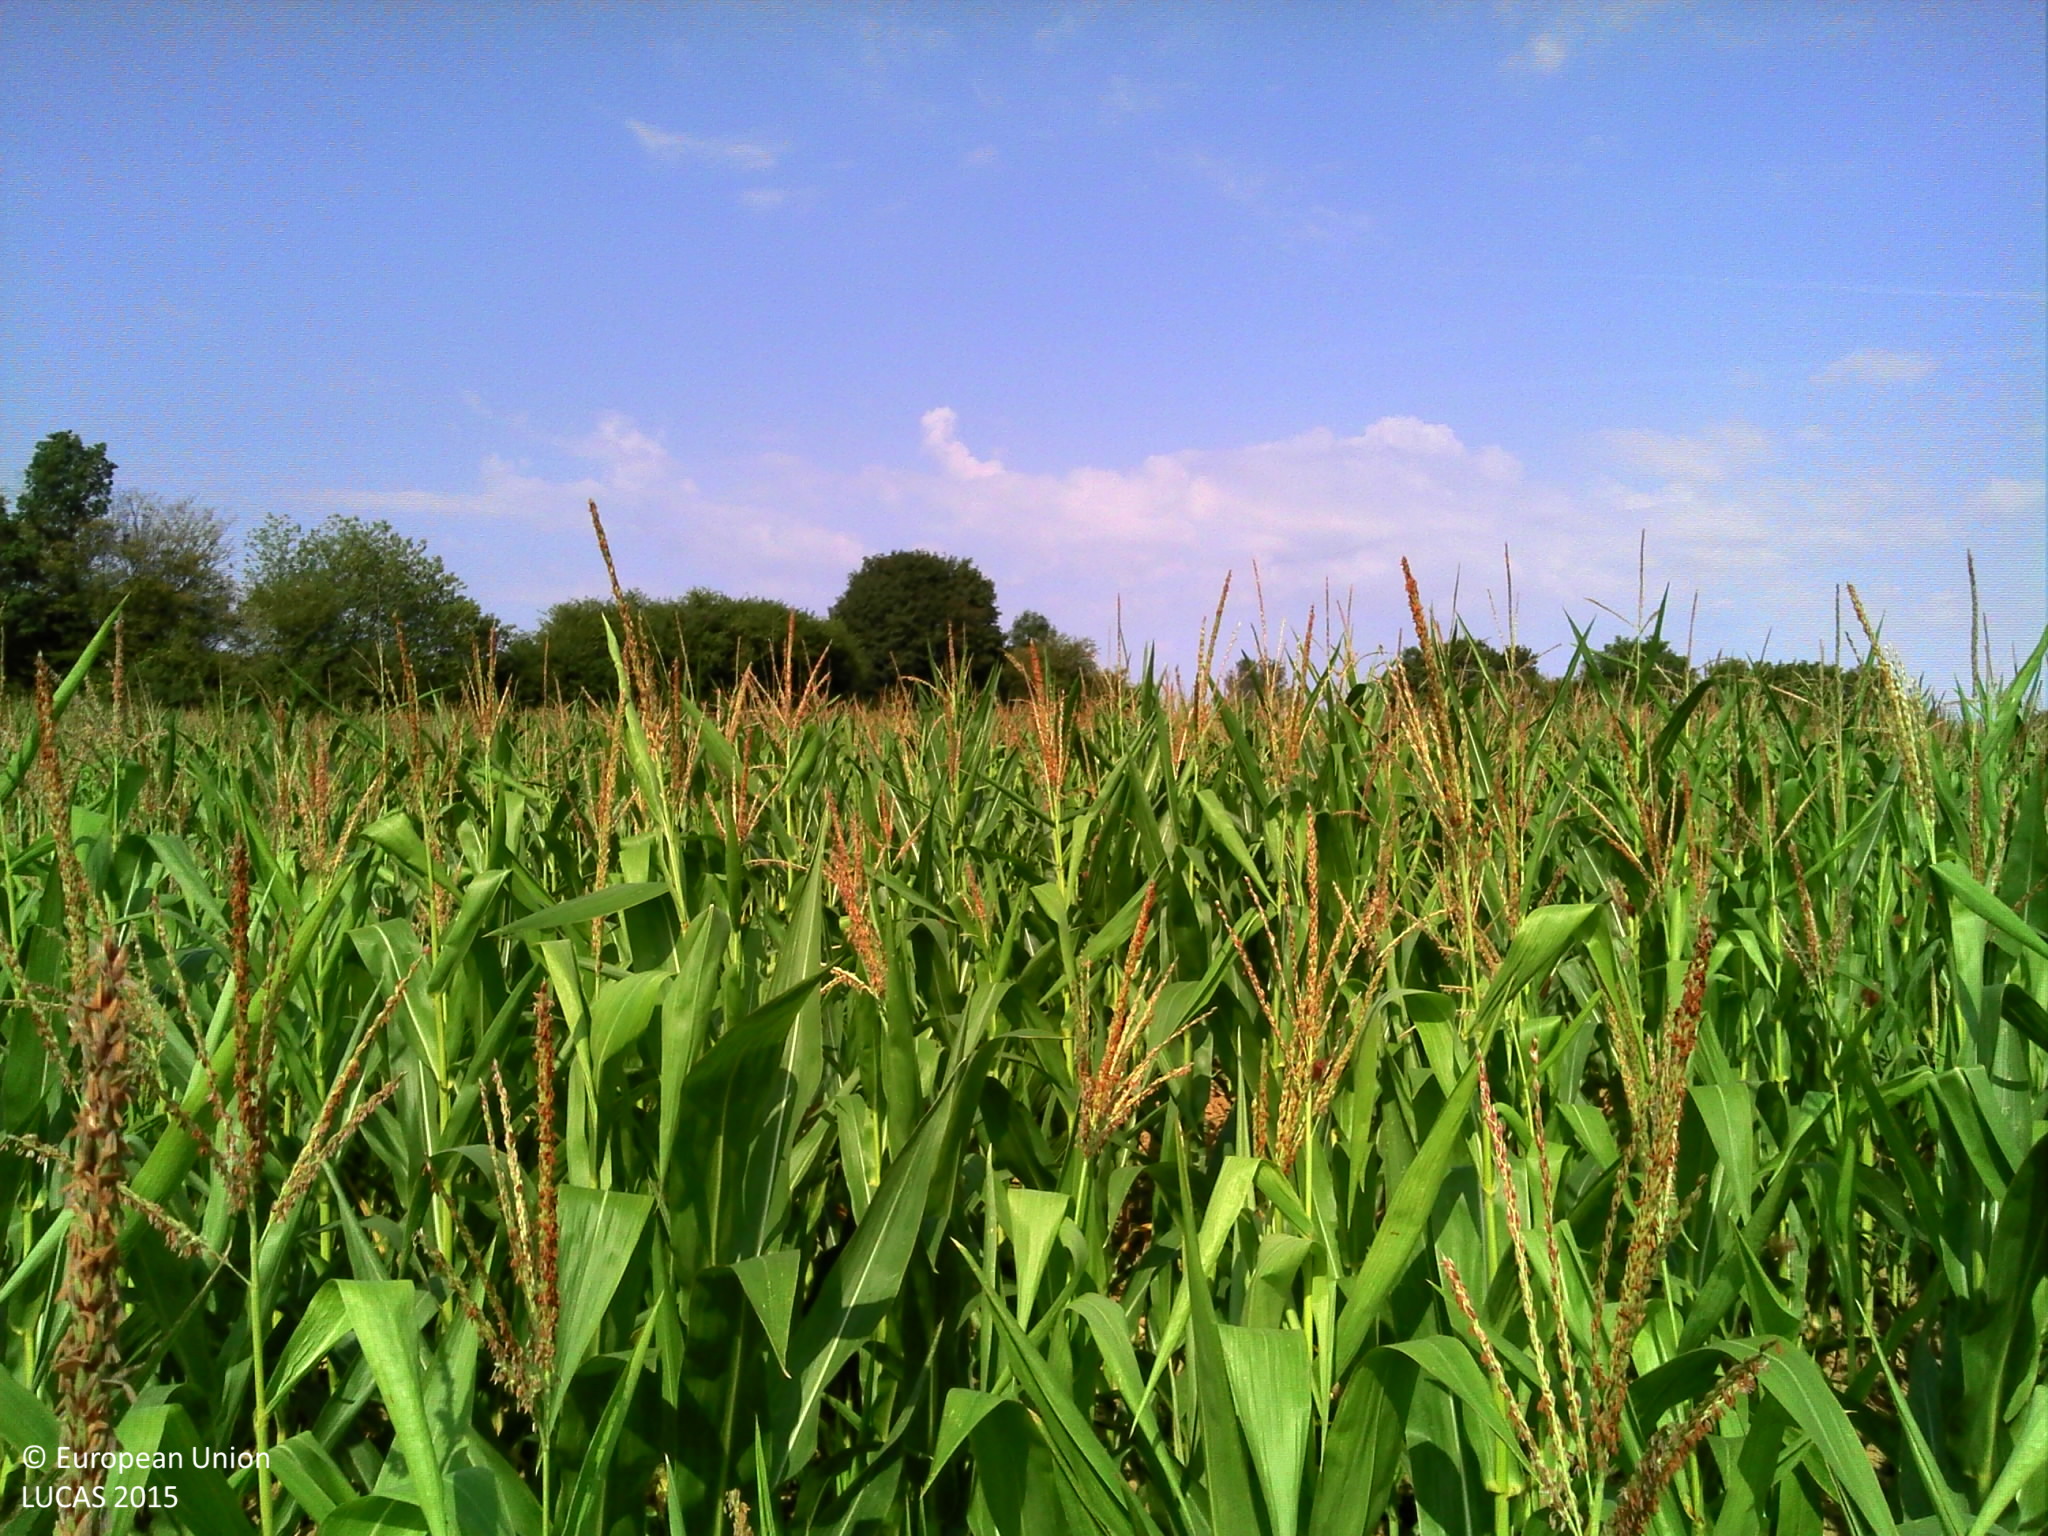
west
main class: Cropland
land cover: Maize
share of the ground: > 75 %
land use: Agriculture (excluding fallow land and kitchen gardens)
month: August
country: FR
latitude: 47.7039
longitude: 3.1578
